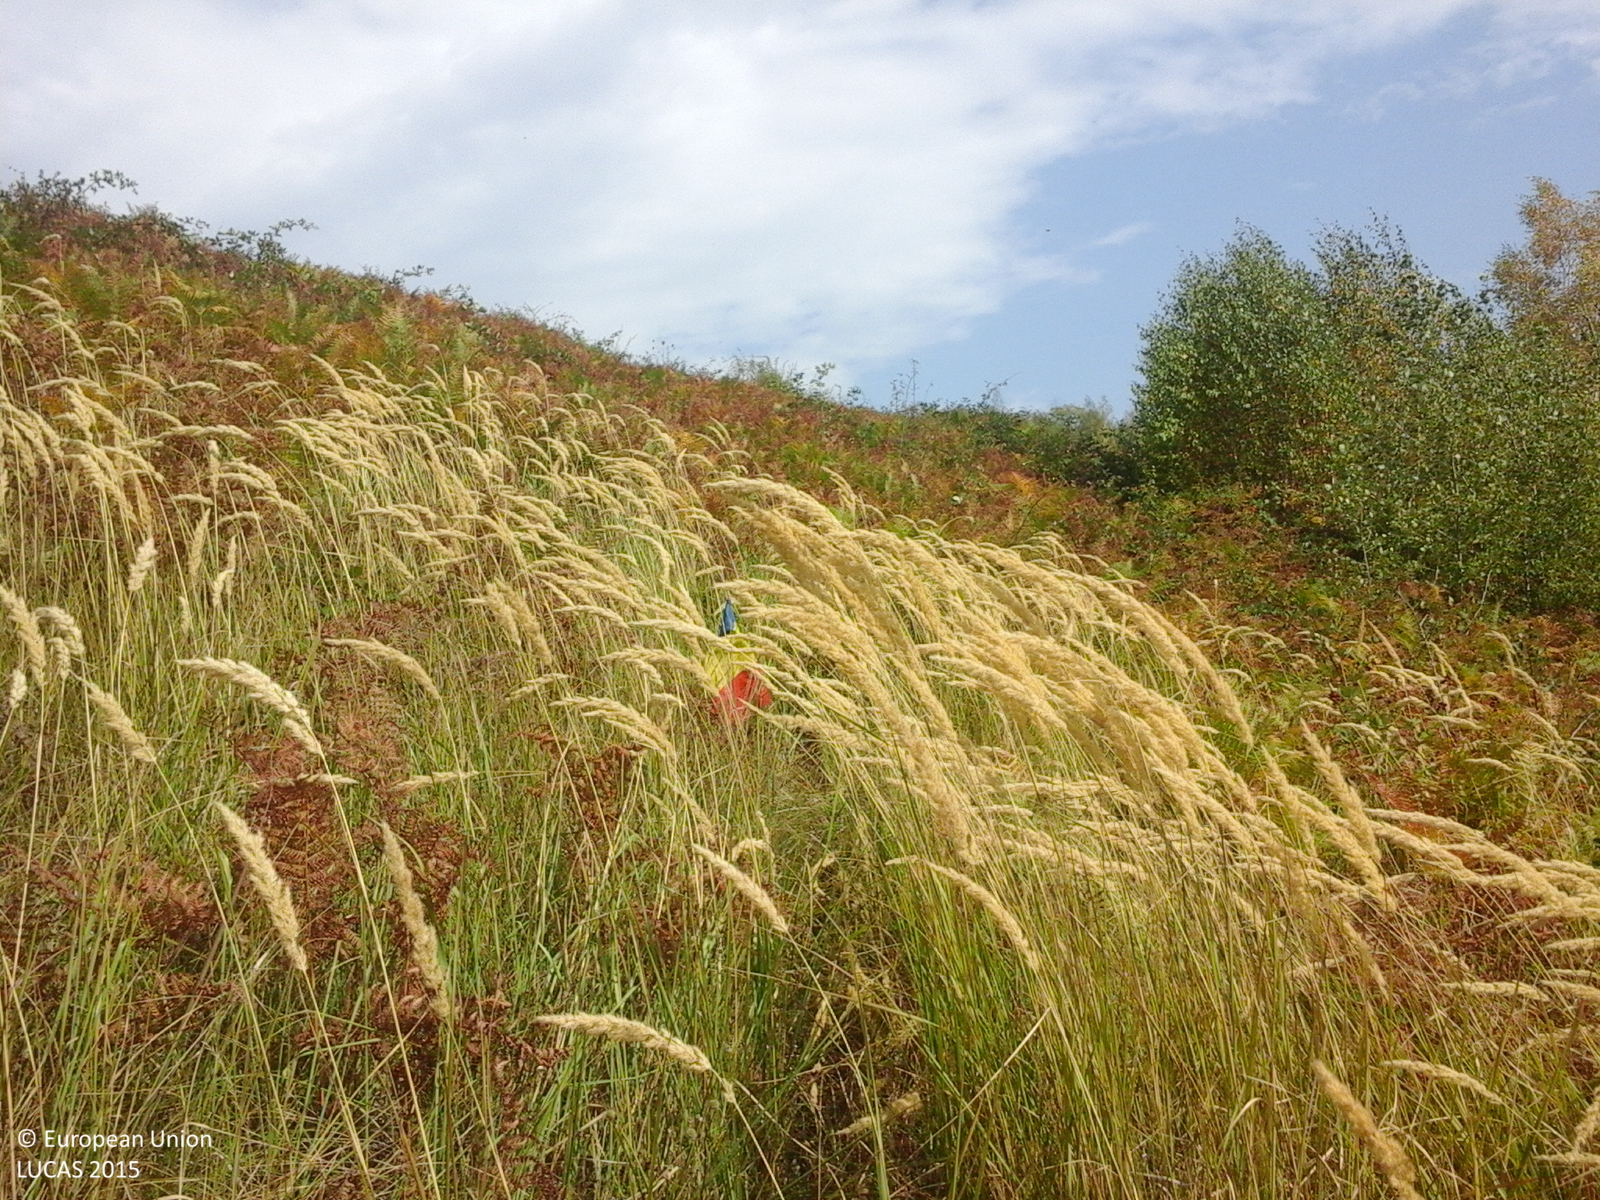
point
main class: Grassland
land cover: Spontaneously vegetated surfaces
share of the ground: > 75 %
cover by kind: herbaceous plants 100 %
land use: Fallow land
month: September
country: RO
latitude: 45.1686
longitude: 22.2669
